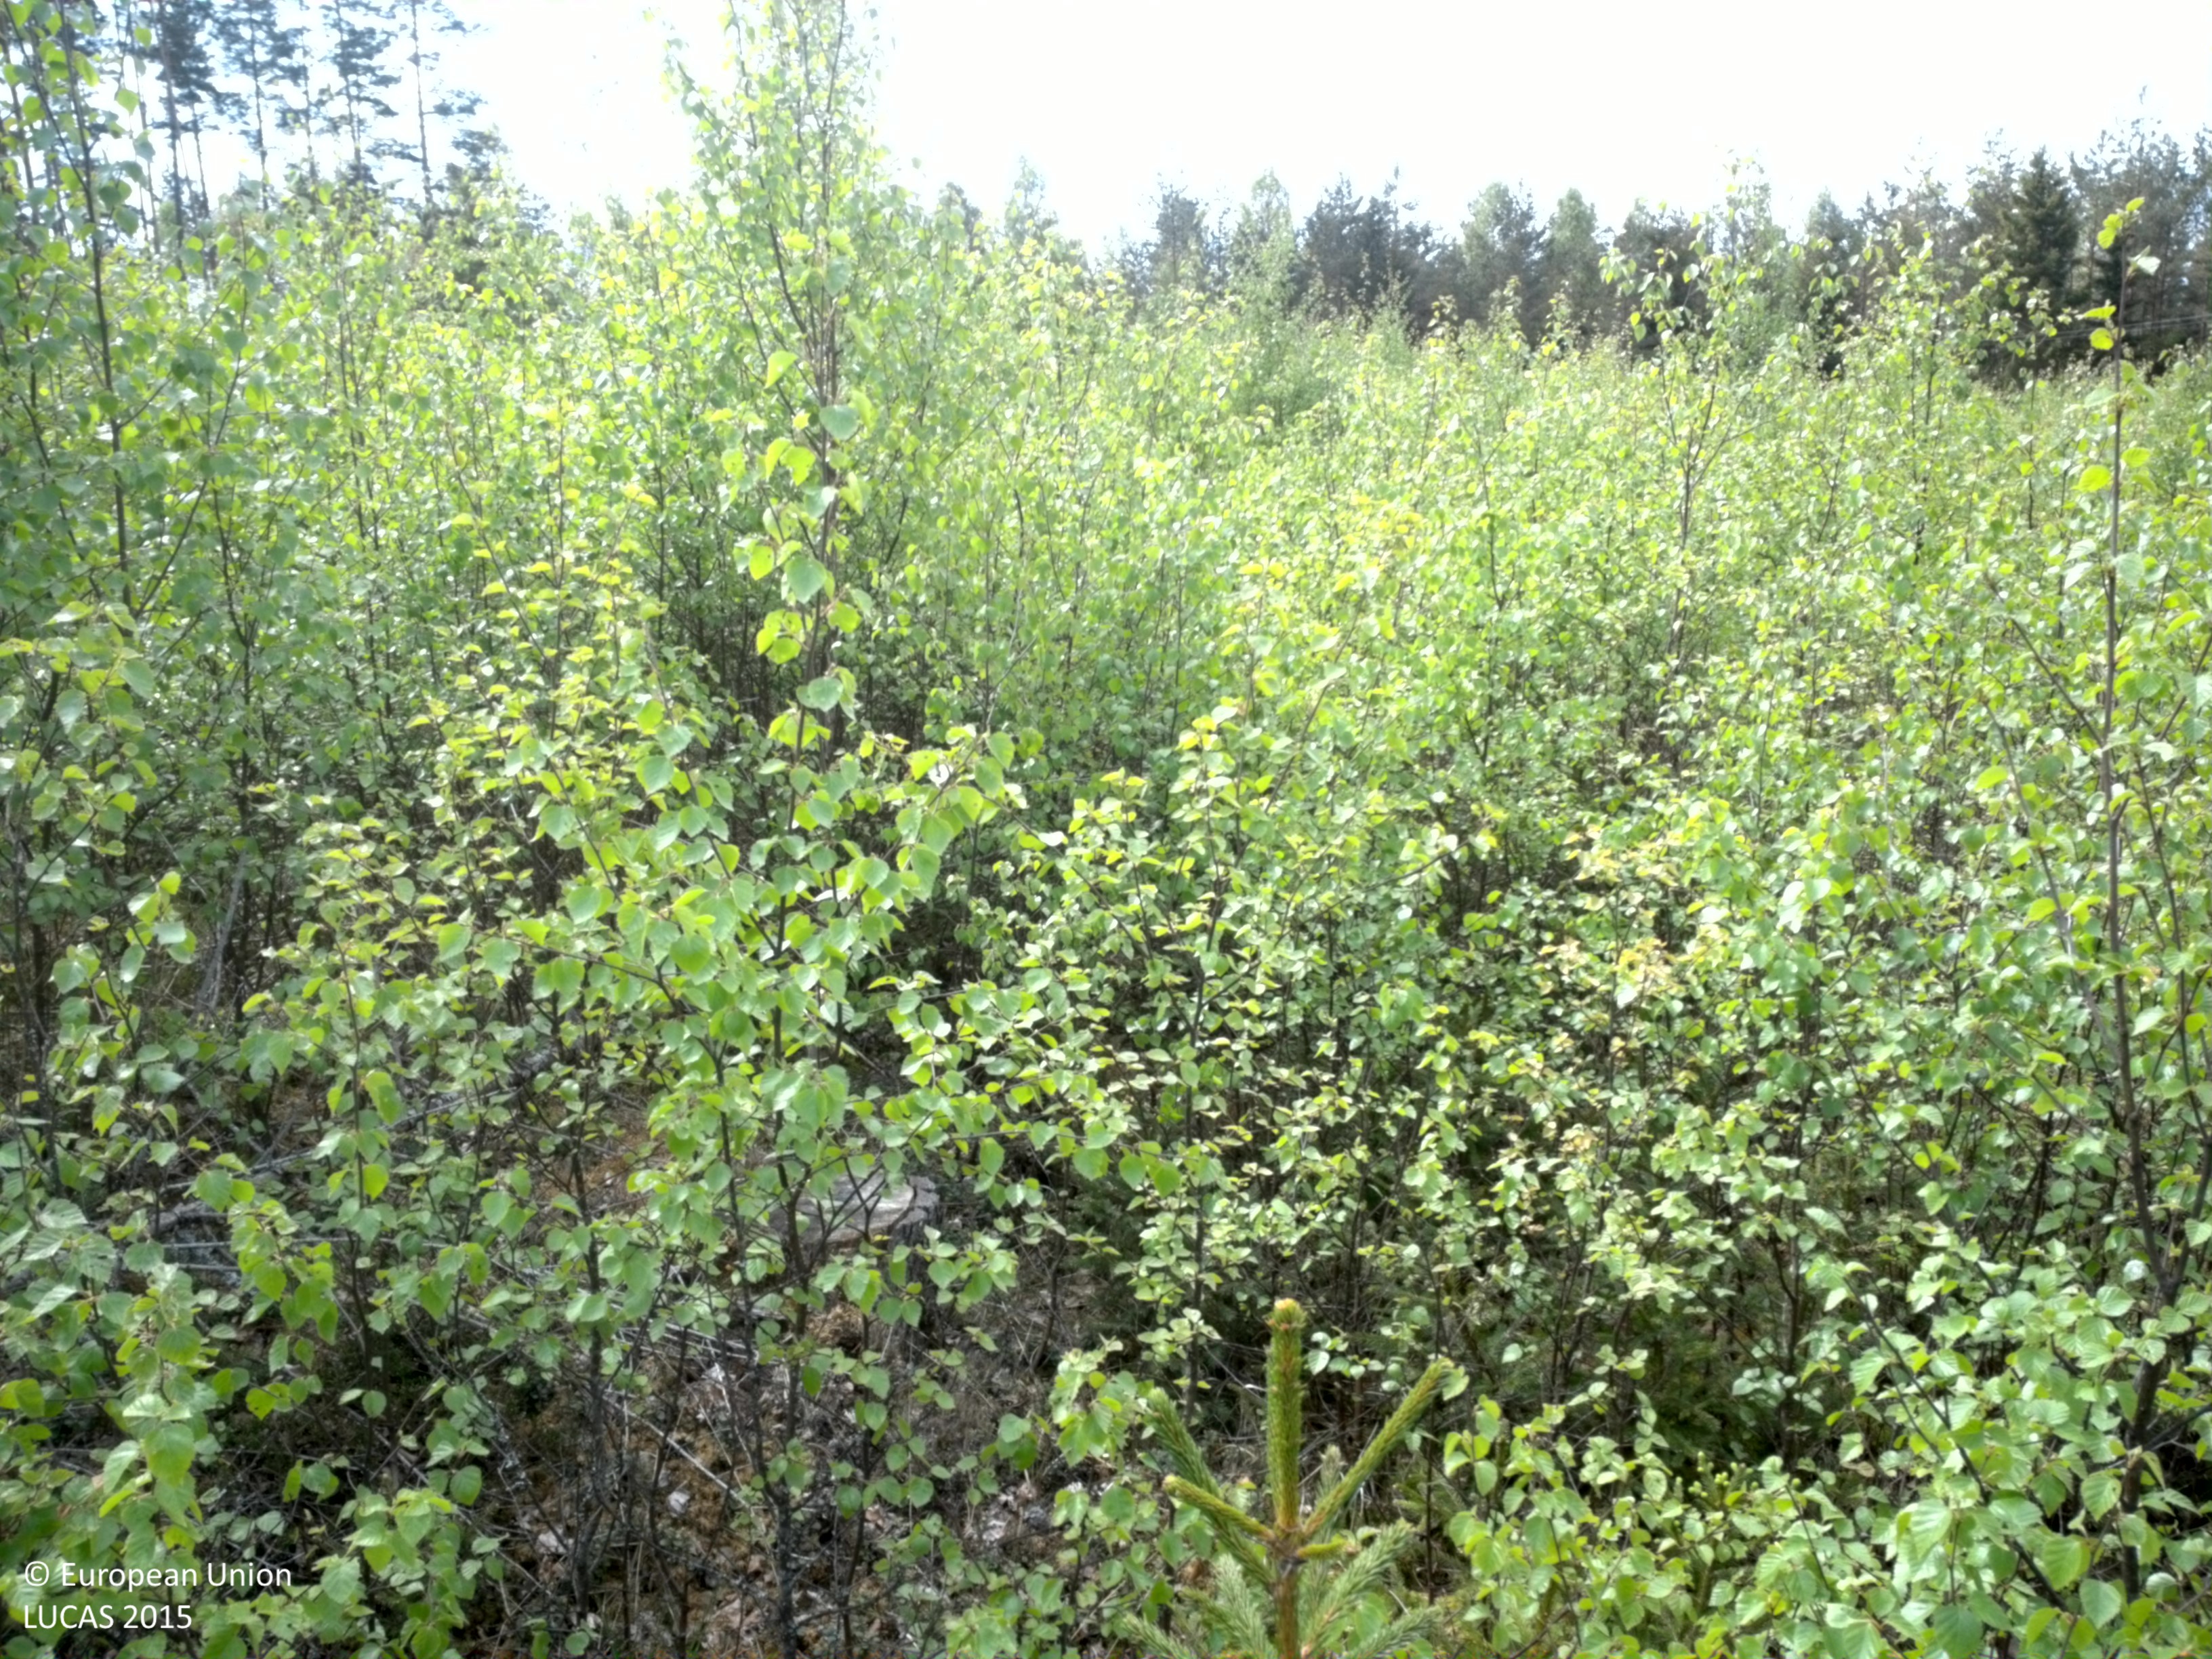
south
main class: Woodland
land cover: Broadleaved woodland
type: hemiboreal forest and nemoral coniferous forest and mixed broadleaved-coniferous forest
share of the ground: > 75 %
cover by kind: broadleaved forest trees 80 %, coniferous forest trees 10 %, shrubs 10 %
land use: Forestry
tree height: < 5 m
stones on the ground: < 10 %
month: May
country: SE
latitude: 56.5156
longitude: 15.1828
